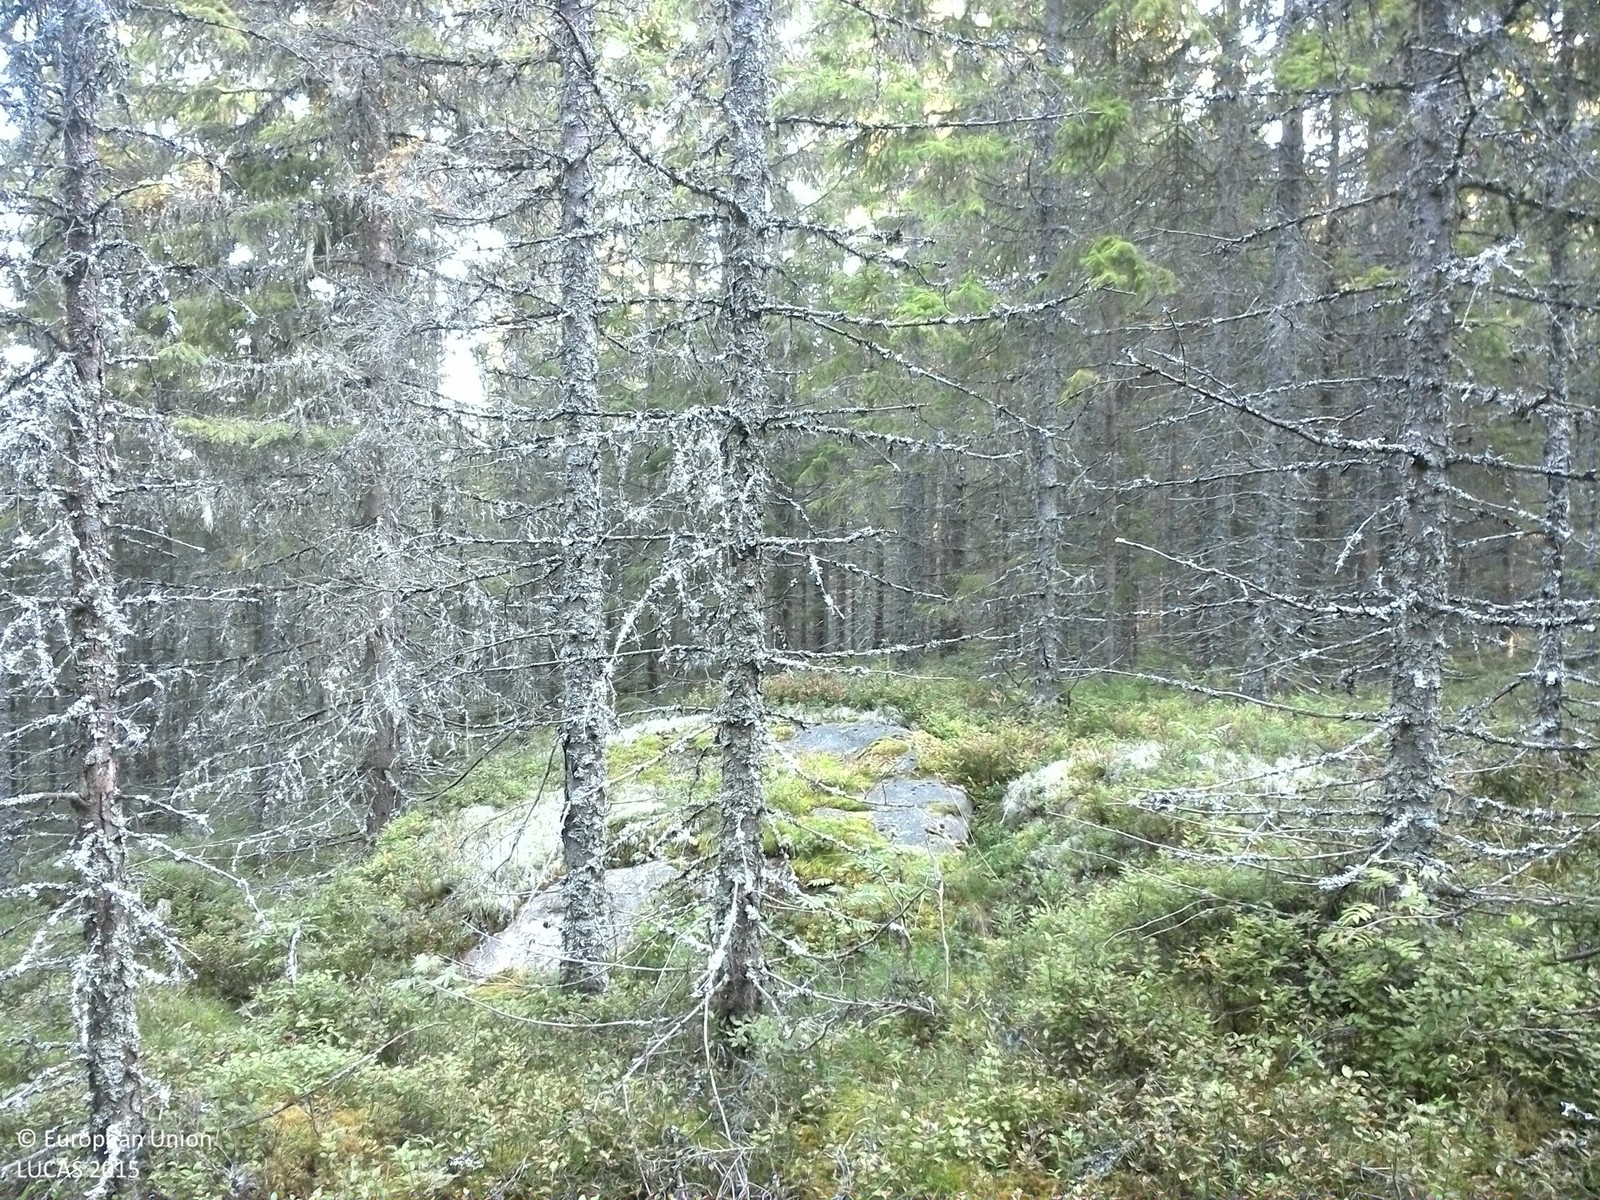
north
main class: Woodland
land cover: Spruce dominated coniferous woodland
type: boreal forest
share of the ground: 50 - 75 %
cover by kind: coniferous forest trees 70 %, shrubs 20 %, lichens and mosses 10 %
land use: Forestry
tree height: > 5 m
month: September
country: SE
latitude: 59.8694
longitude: 13.4025
